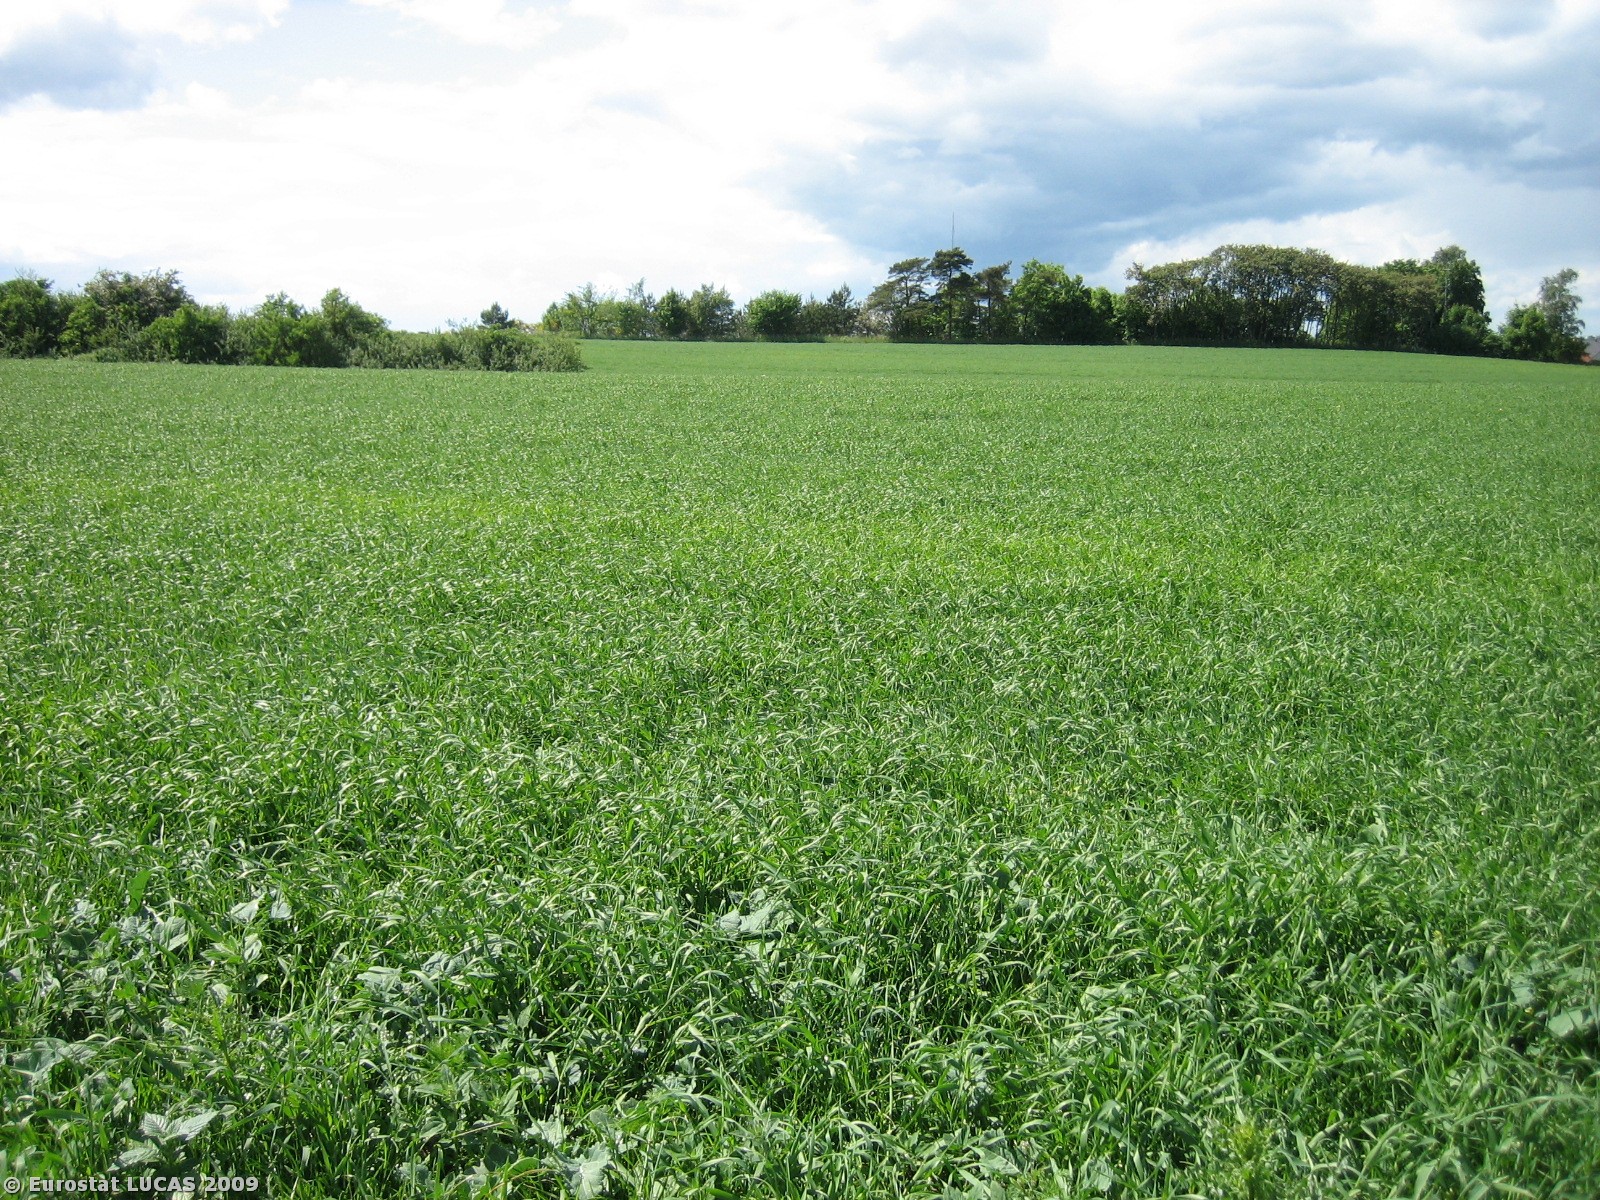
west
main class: Cropland
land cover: Barley
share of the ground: > 75 %
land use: Agriculture (excluding fallow land and kitchen gardens)
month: June
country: DK
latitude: 56.2954
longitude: 9.7902
